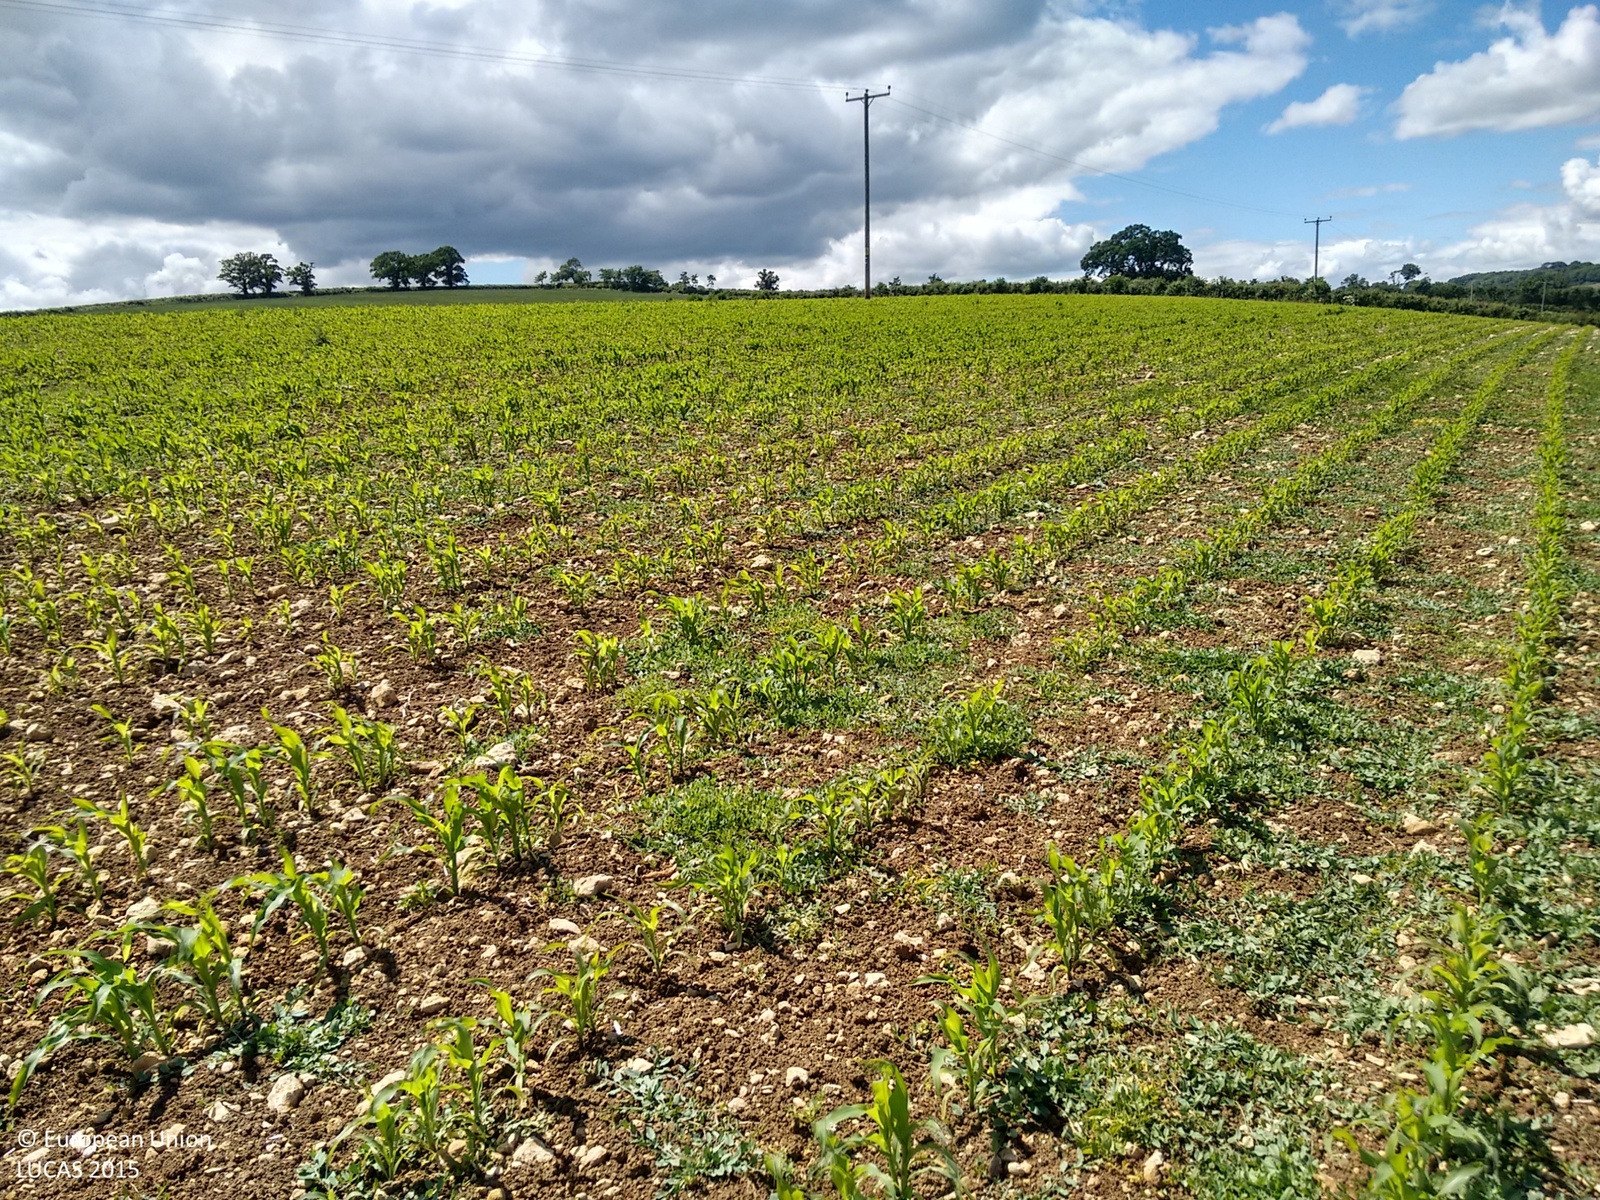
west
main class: Cropland
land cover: Maize
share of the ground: 10 - 25 %
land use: Agriculture (excluding fallow land and kitchen gardens)
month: June
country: GB
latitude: 51.2717
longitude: -2.3771
